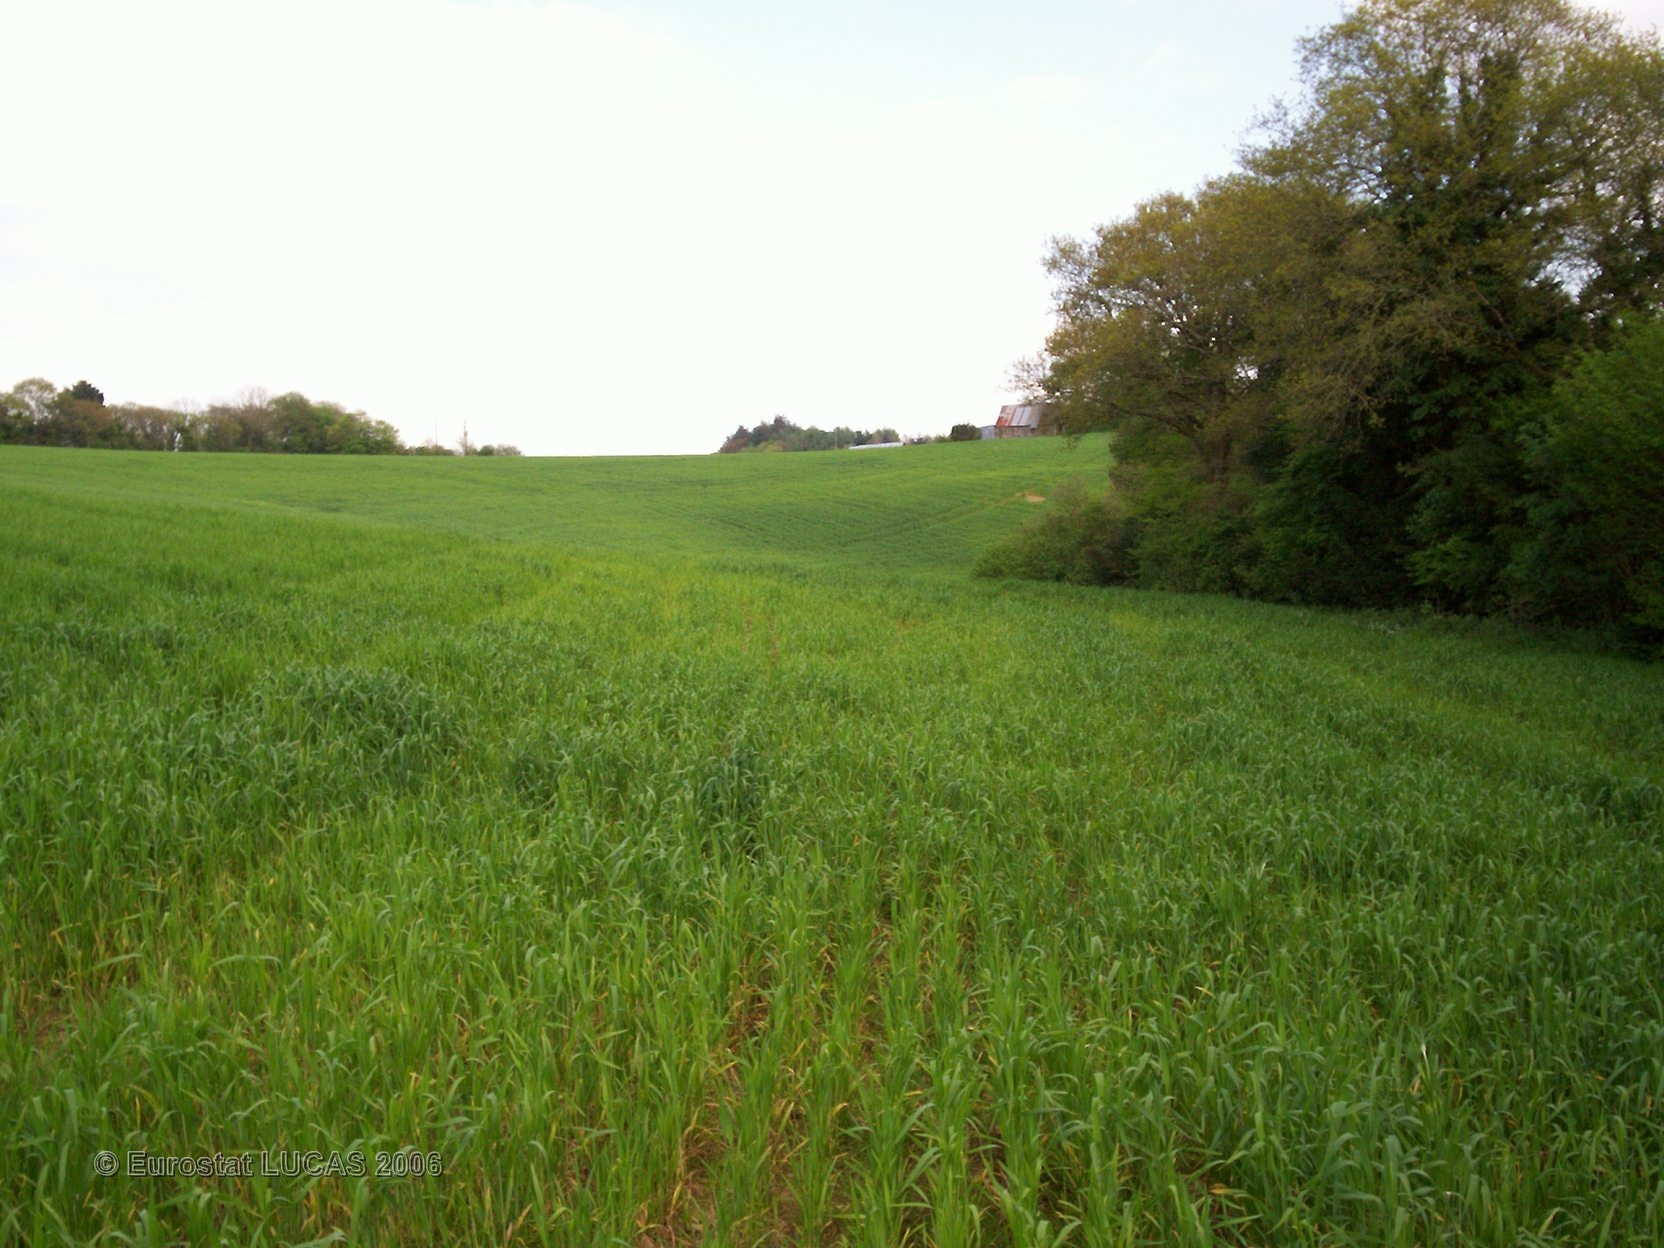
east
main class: Cropland
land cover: Barley
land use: Agriculture (excluding fallow land and kitchen gardens)
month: May
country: FR
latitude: 48.3909
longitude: -3.6537
